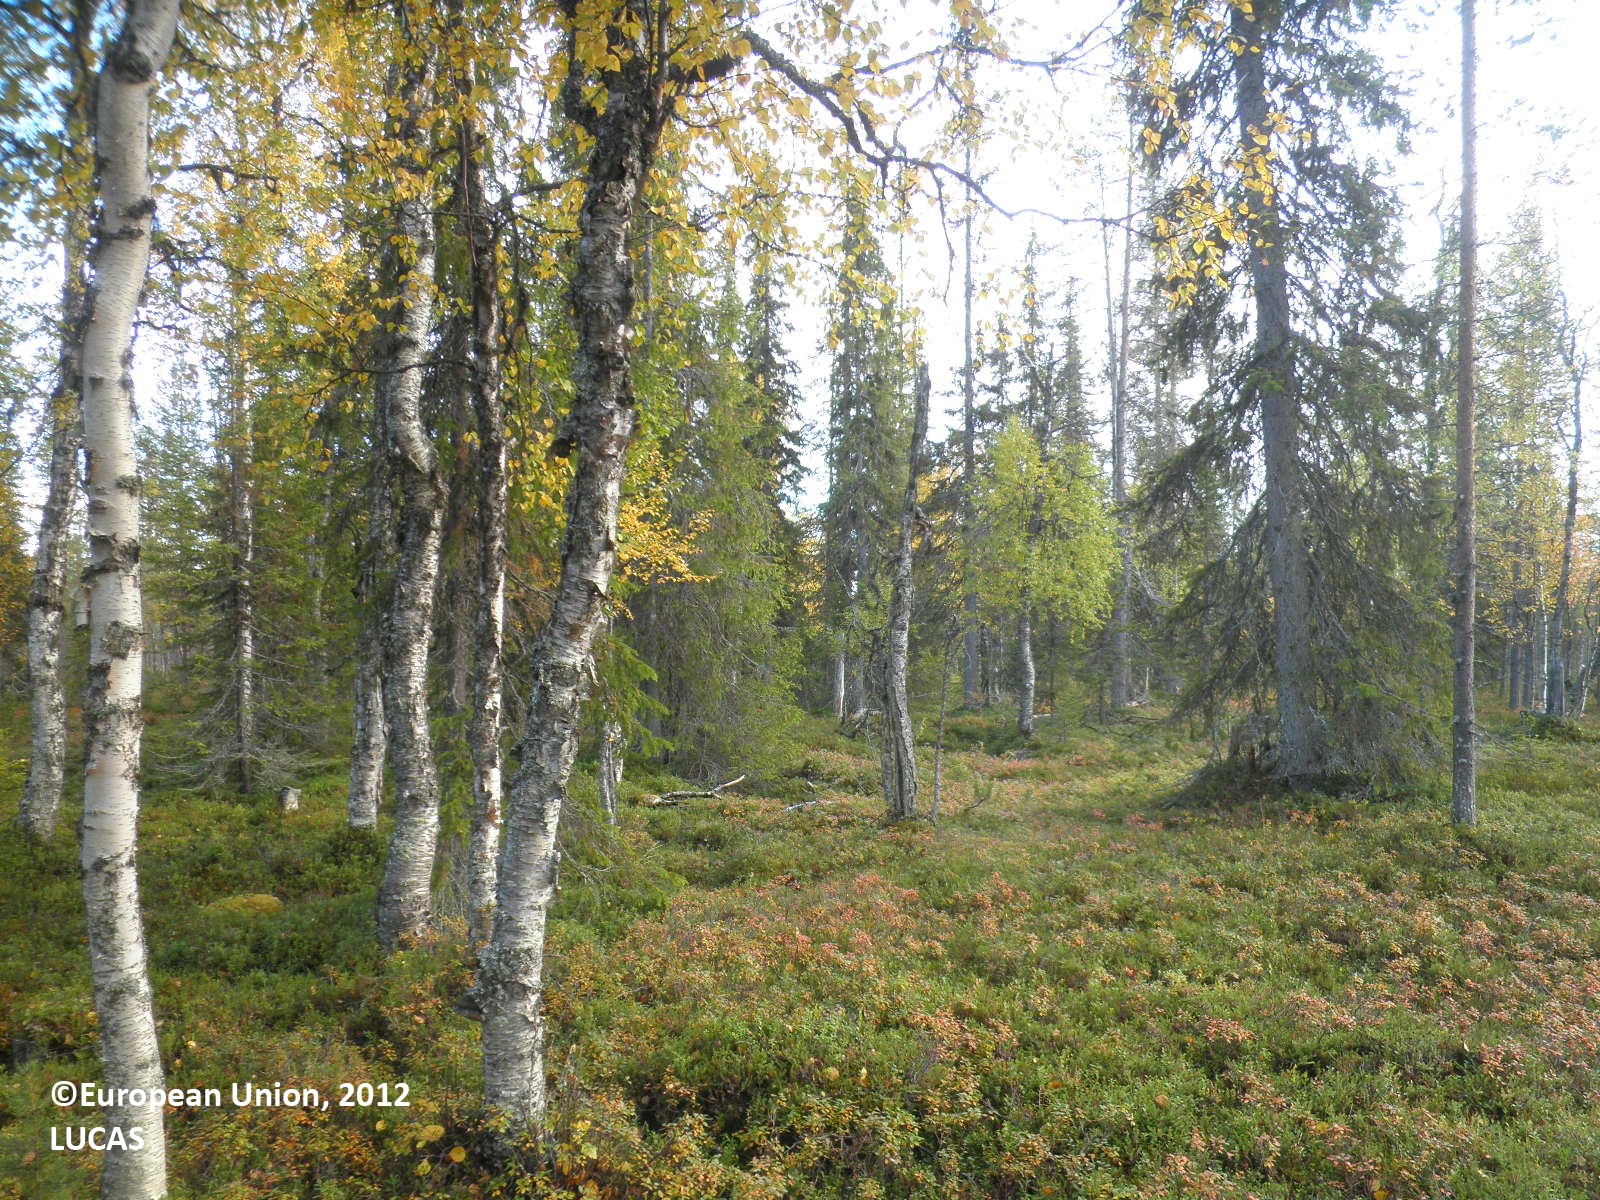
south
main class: Woodland
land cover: Spruce dominated mixed woodland
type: boreal forest
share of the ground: 25 - 50 %
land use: Forestry
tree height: > 5 m
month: September
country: FI
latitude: 67.7646
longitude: 28.7202
